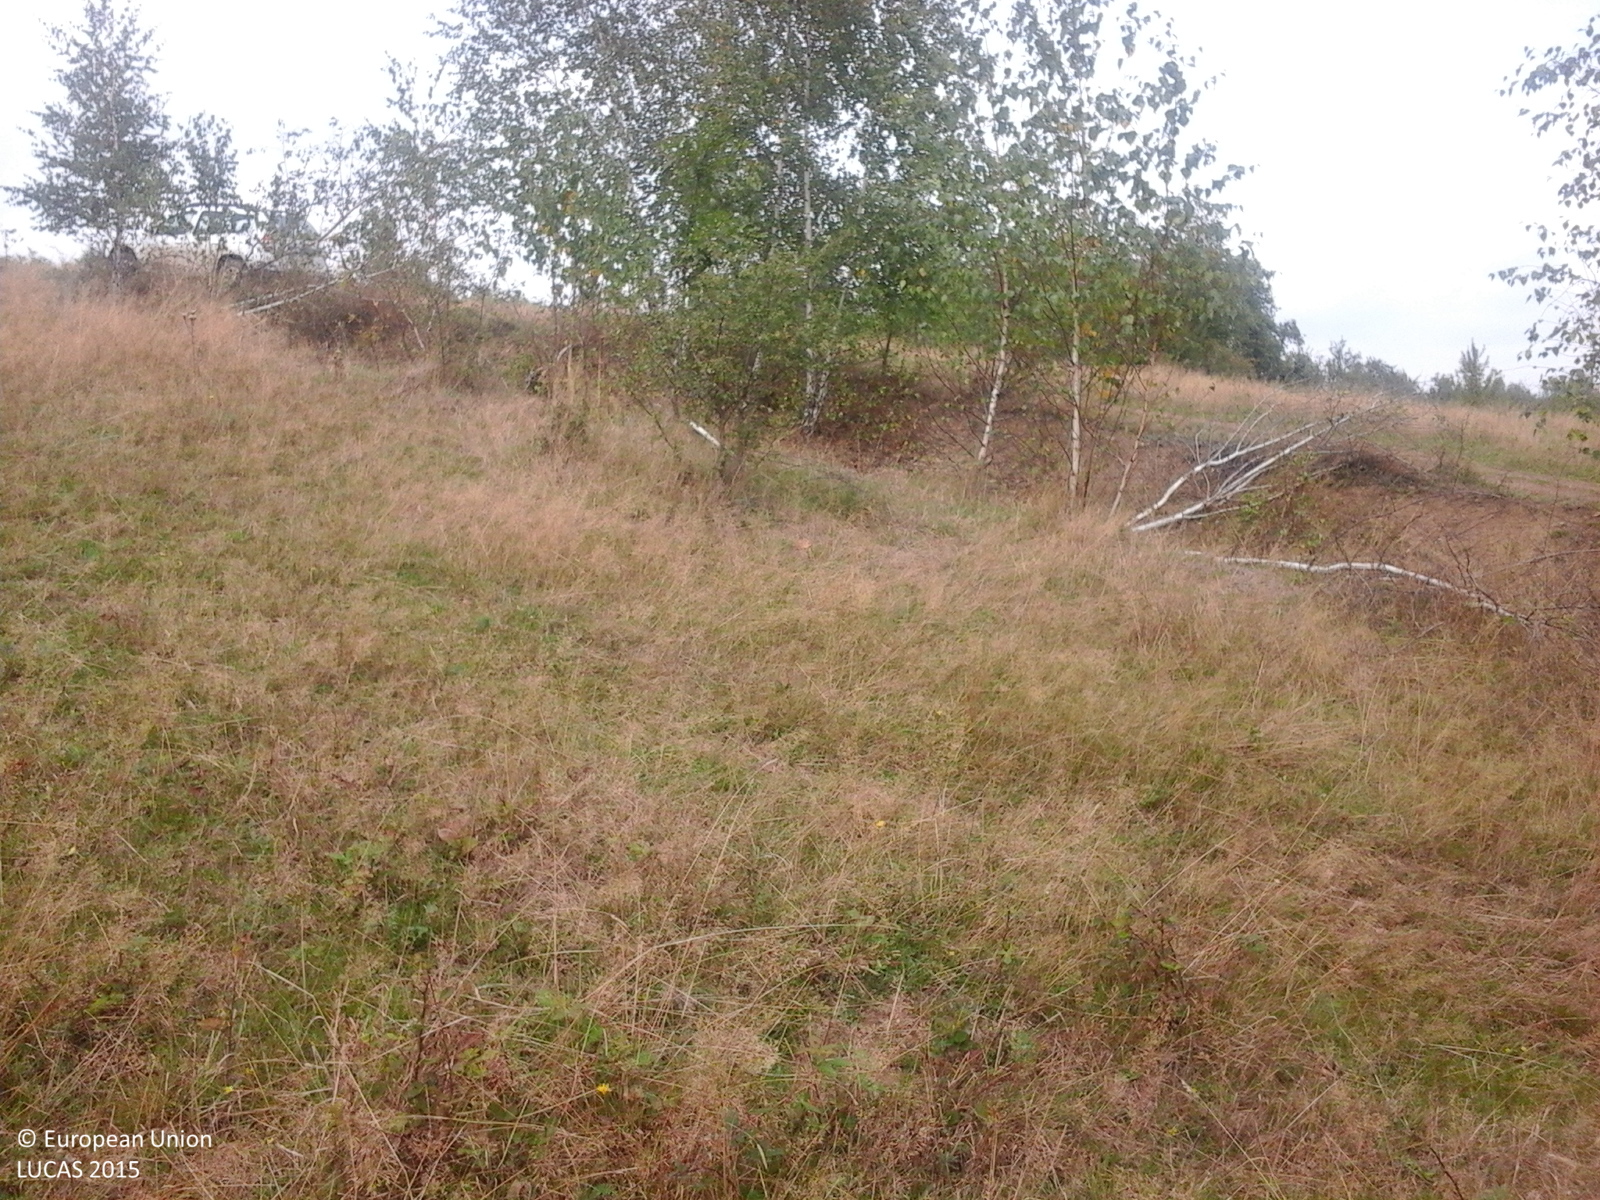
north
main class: Grassland
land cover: Grassland without tree/shrub cover
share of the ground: > 75 %
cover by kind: herbaceous plants 100 %
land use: Agriculture (excluding fallow land and kitchen gardens)
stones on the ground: < 10 %
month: September
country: RO
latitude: 46.9211
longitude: 22.5429
